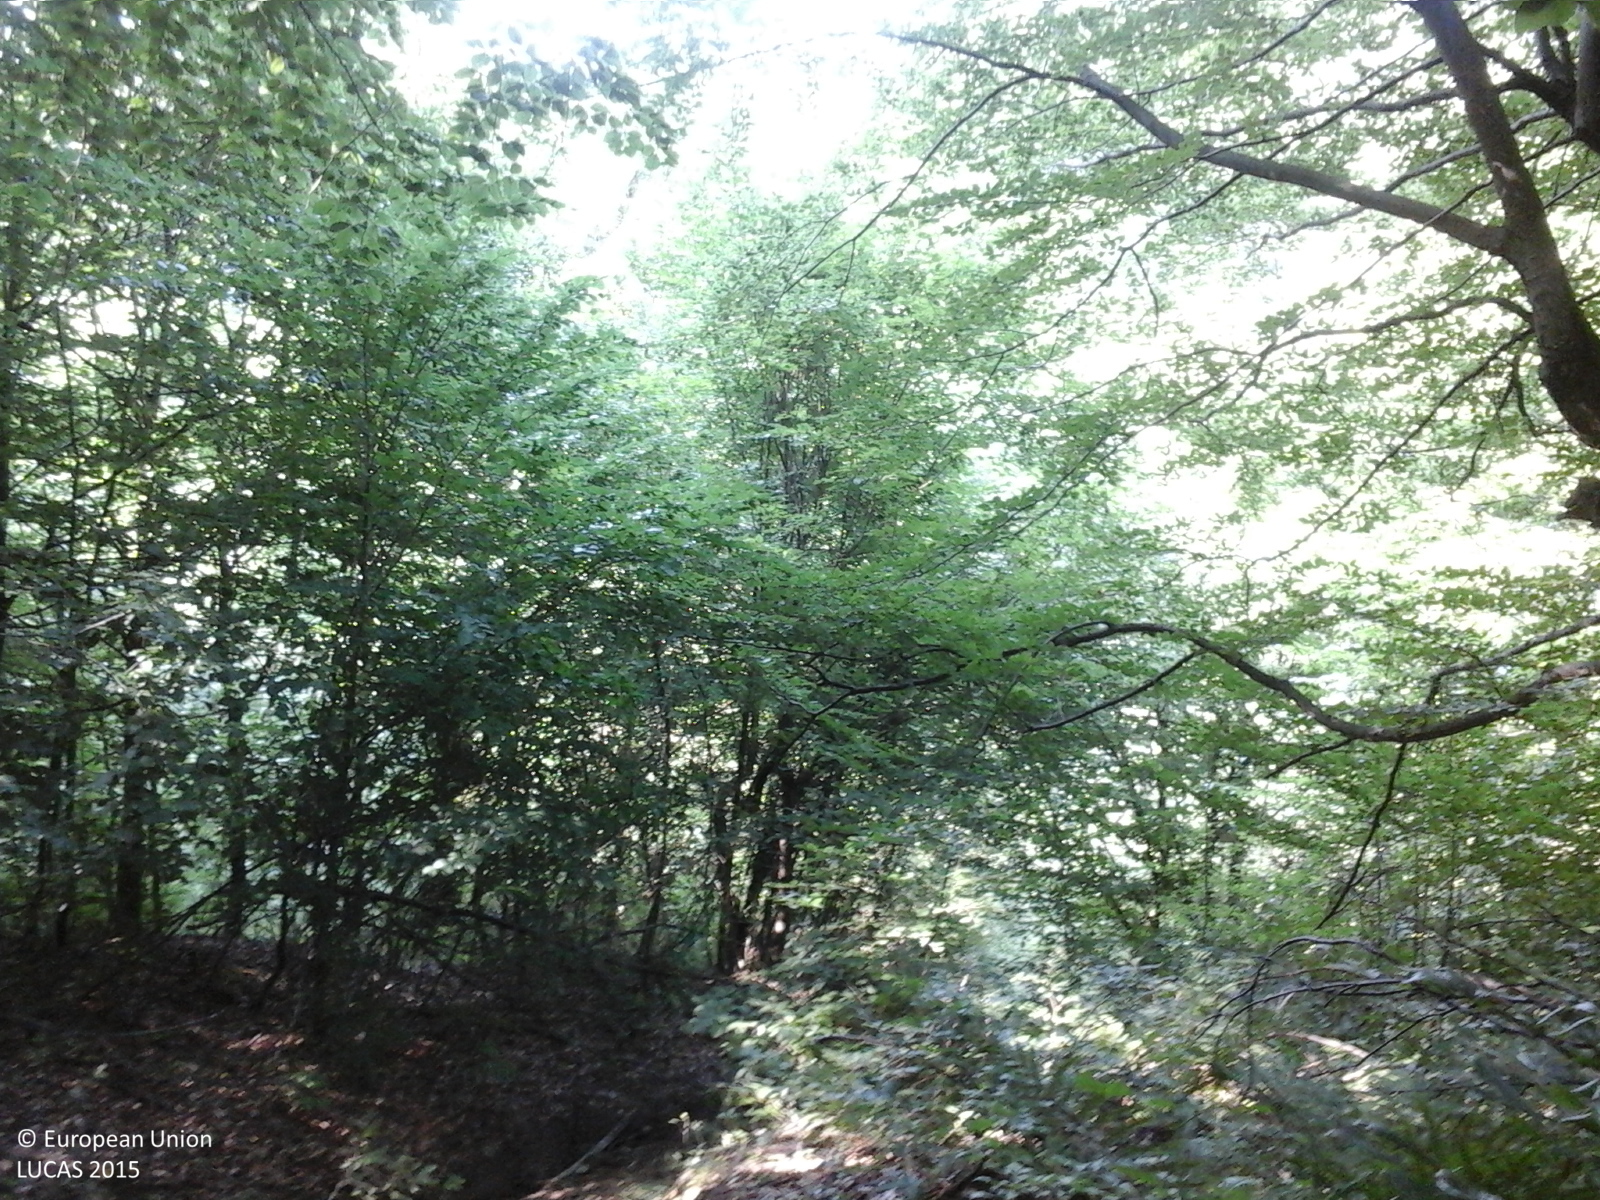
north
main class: Woodland
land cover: Broadleaved woodland
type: beech forest
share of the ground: > 75 %
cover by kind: broadleaved forest trees 100 %
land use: Forestry
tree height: > 5 m
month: July
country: RO
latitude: 45.0619
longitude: 24.7748
